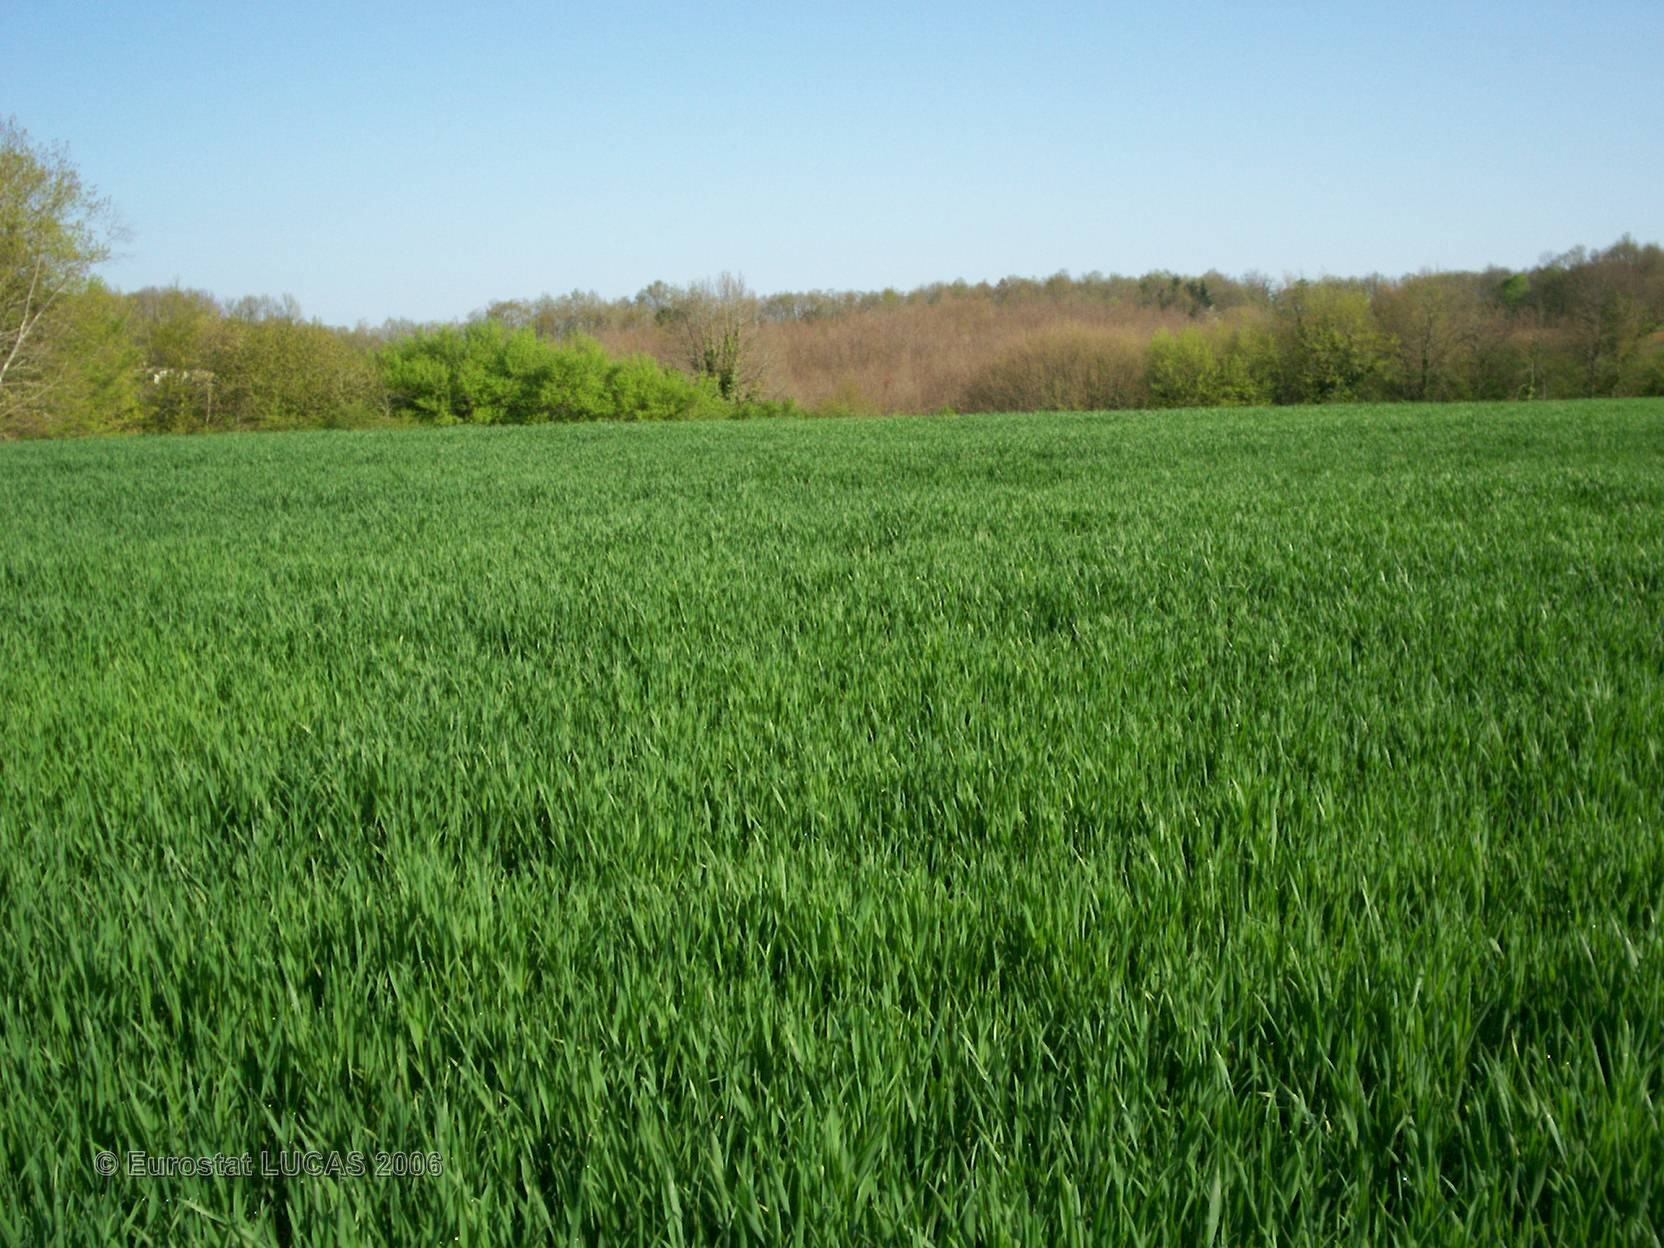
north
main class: Cropland
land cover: Common wheat
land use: Agriculture (excluding fallow land and kitchen gardens)
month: April
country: FR
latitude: 45.5711
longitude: 0.5691
